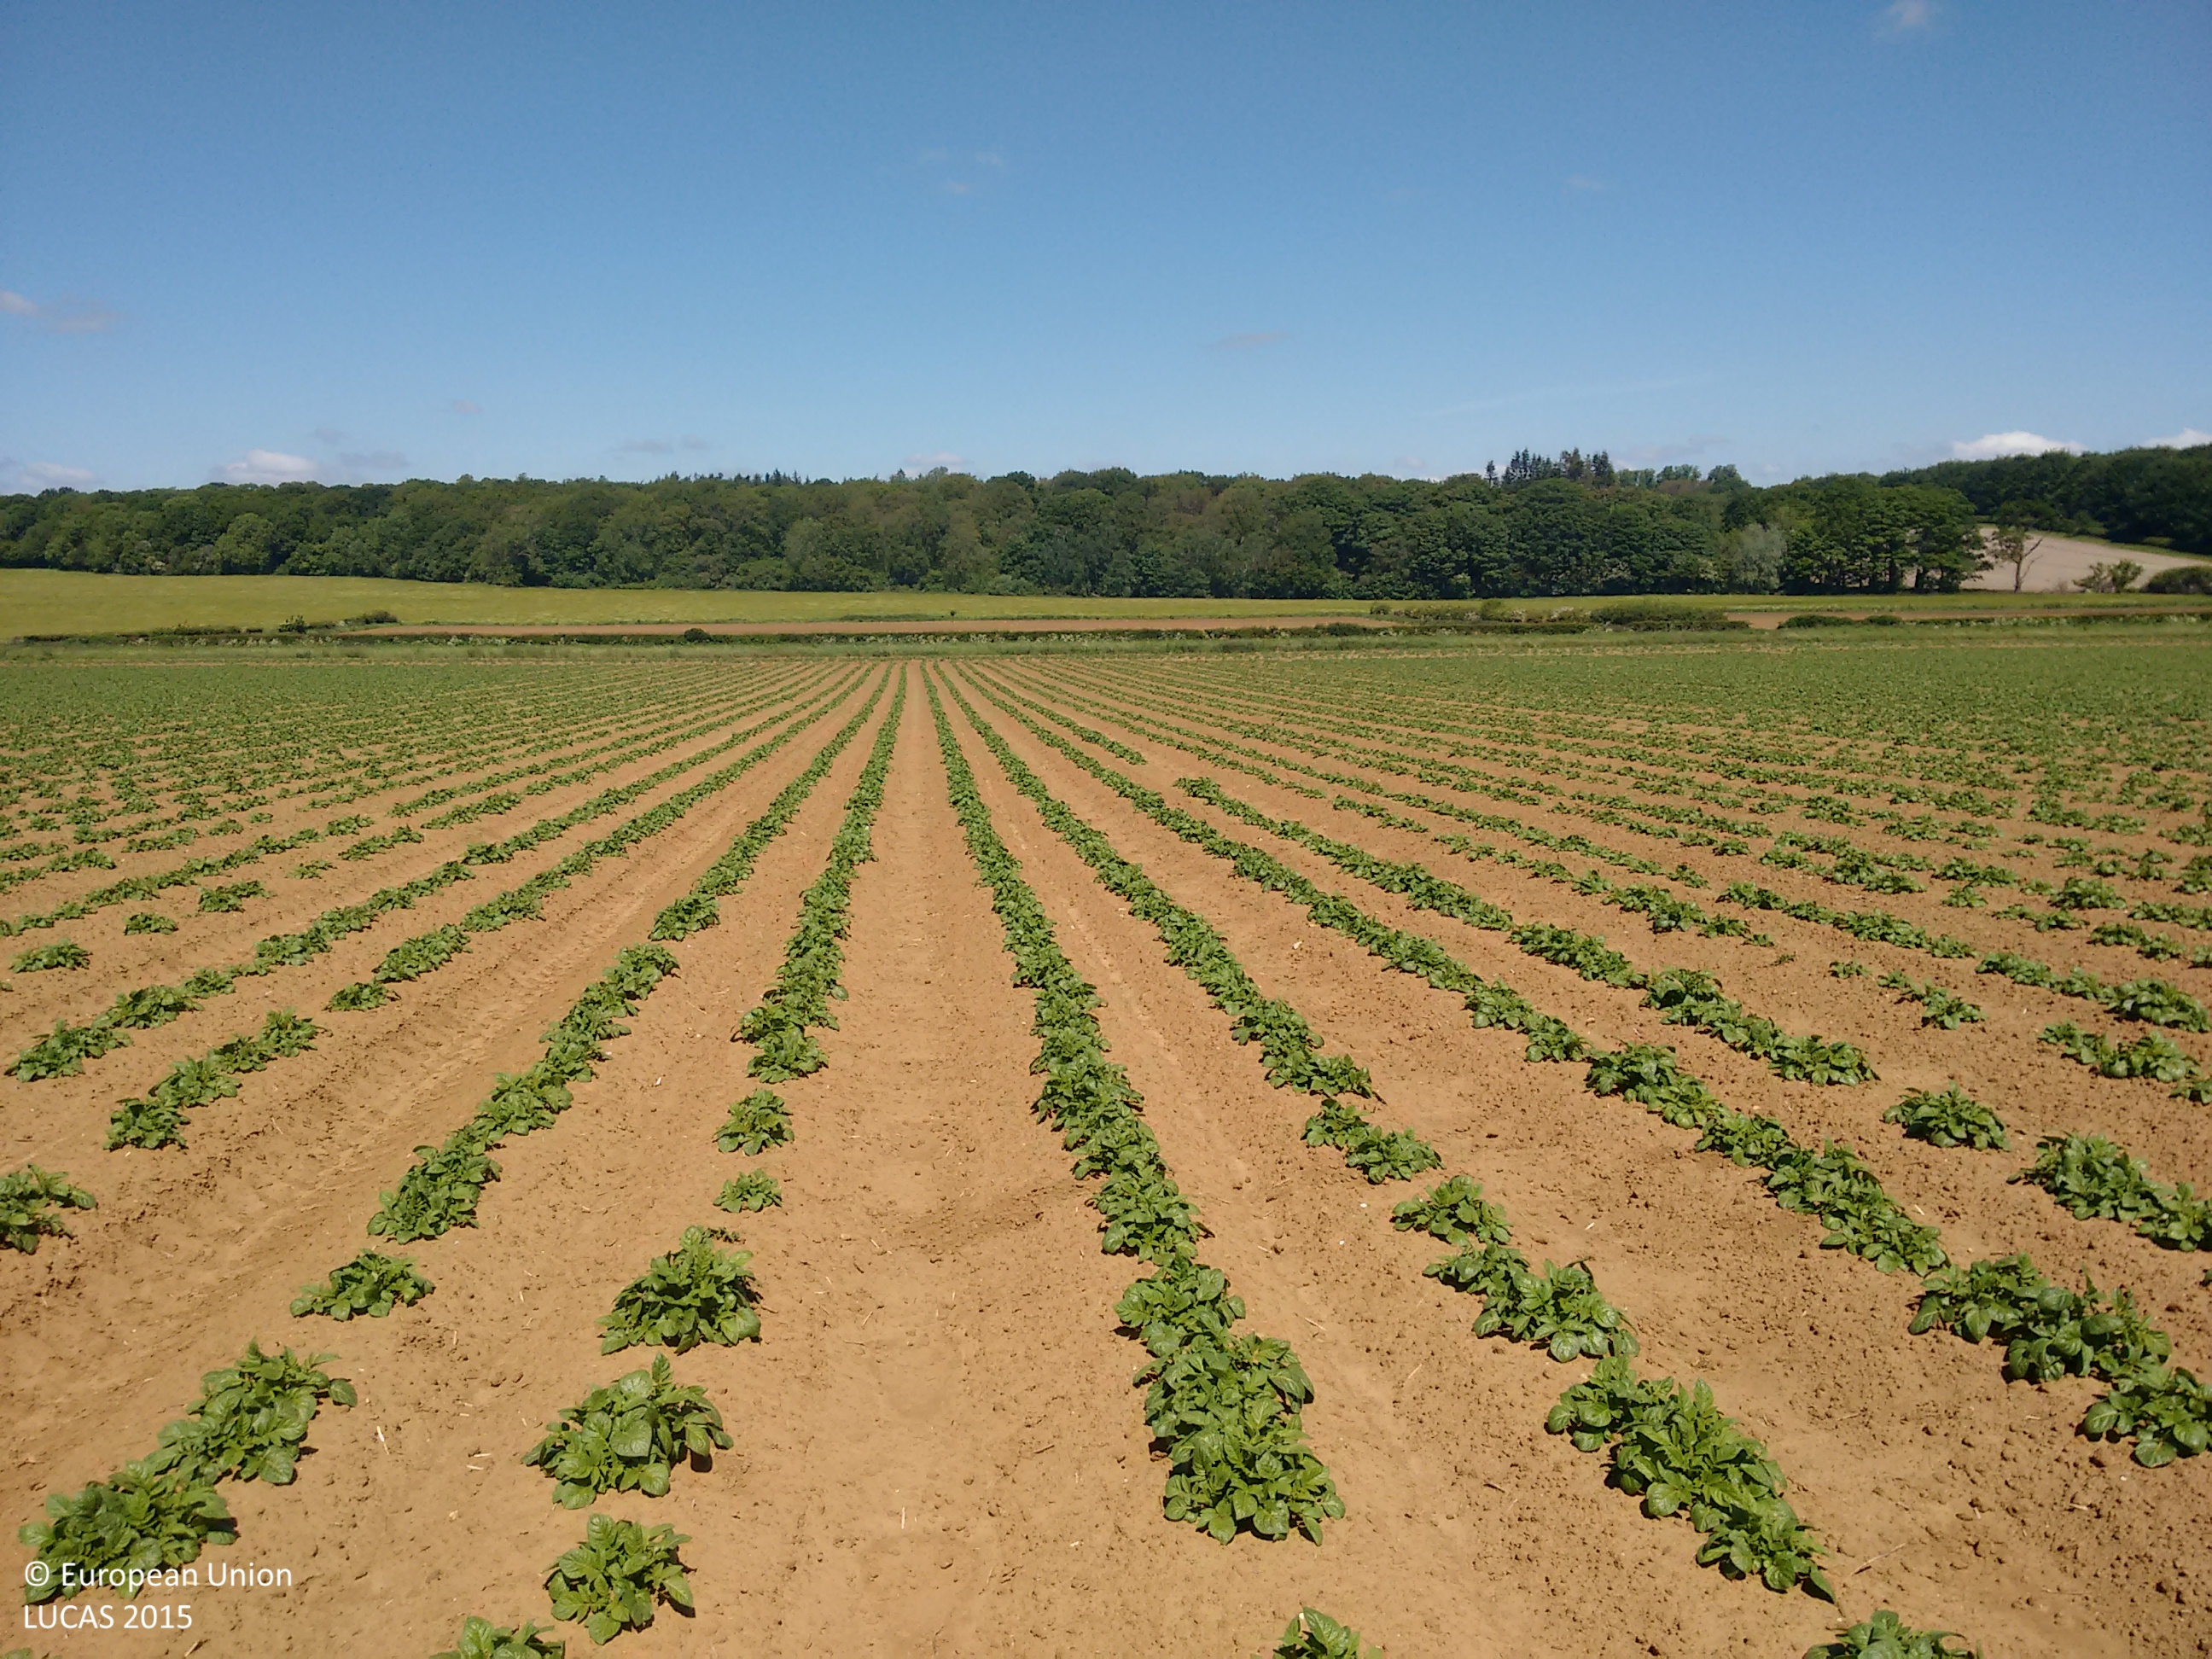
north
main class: Cropland
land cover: Potatoes
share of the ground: 10 - 25 %
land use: Agriculture (excluding fallow land and kitchen gardens)
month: June
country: GB
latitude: 54.1048
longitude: -0.9155
